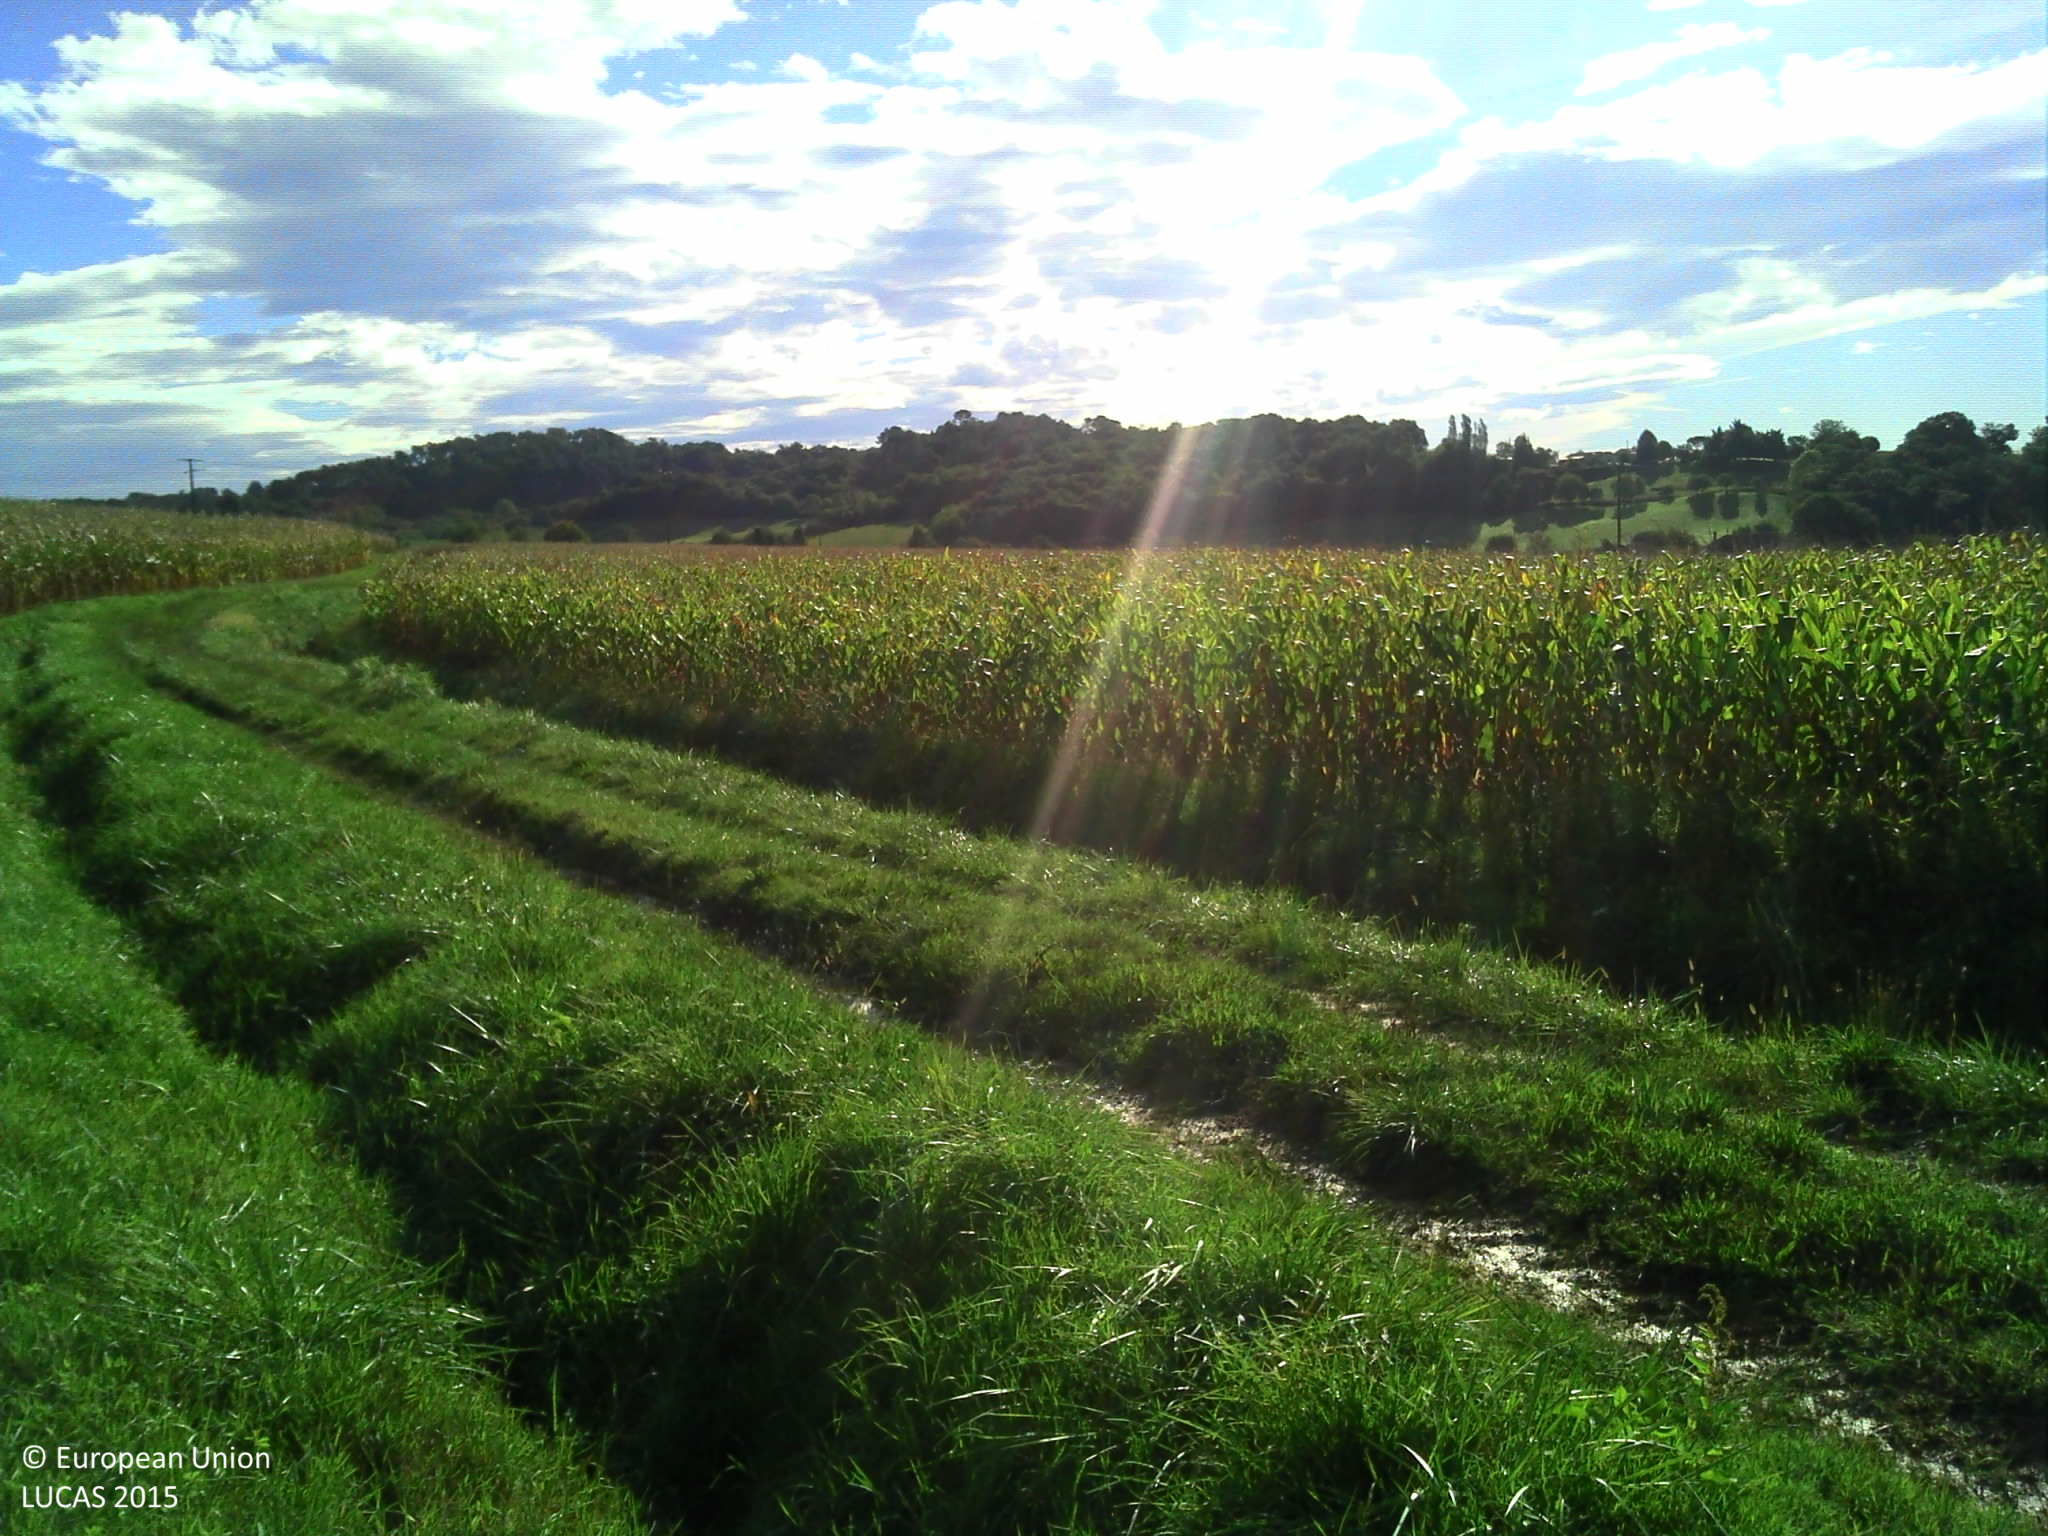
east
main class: Cropland
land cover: Maize
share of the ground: > 75 %
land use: Agriculture (excluding fallow land and kitchen gardens)
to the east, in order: Maize
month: September
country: FR
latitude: 43.4859
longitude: -0.7063
